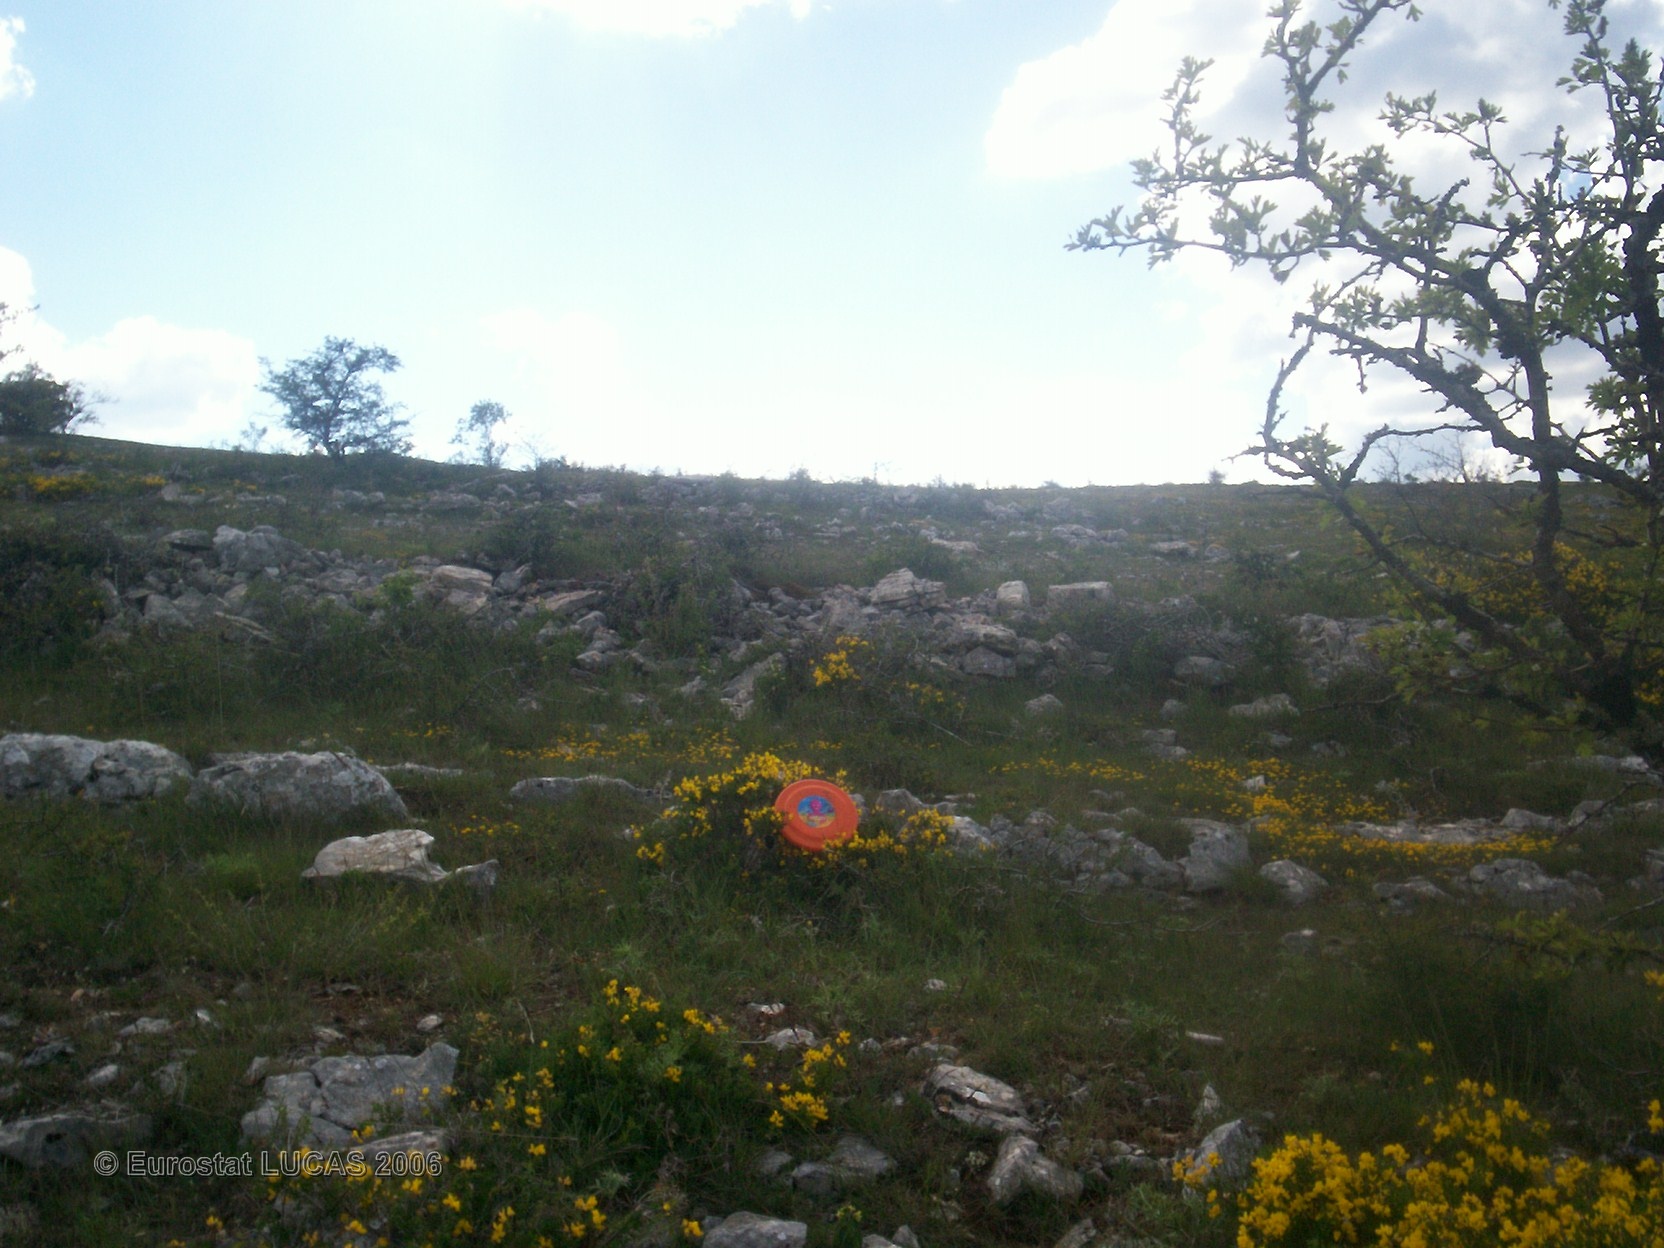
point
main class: Grassland
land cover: Grassland without tree/shrub cover
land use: Agriculture (excluding fallow land and kitchen gardens)
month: June
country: FR
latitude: 44.2525
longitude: 3.4560
